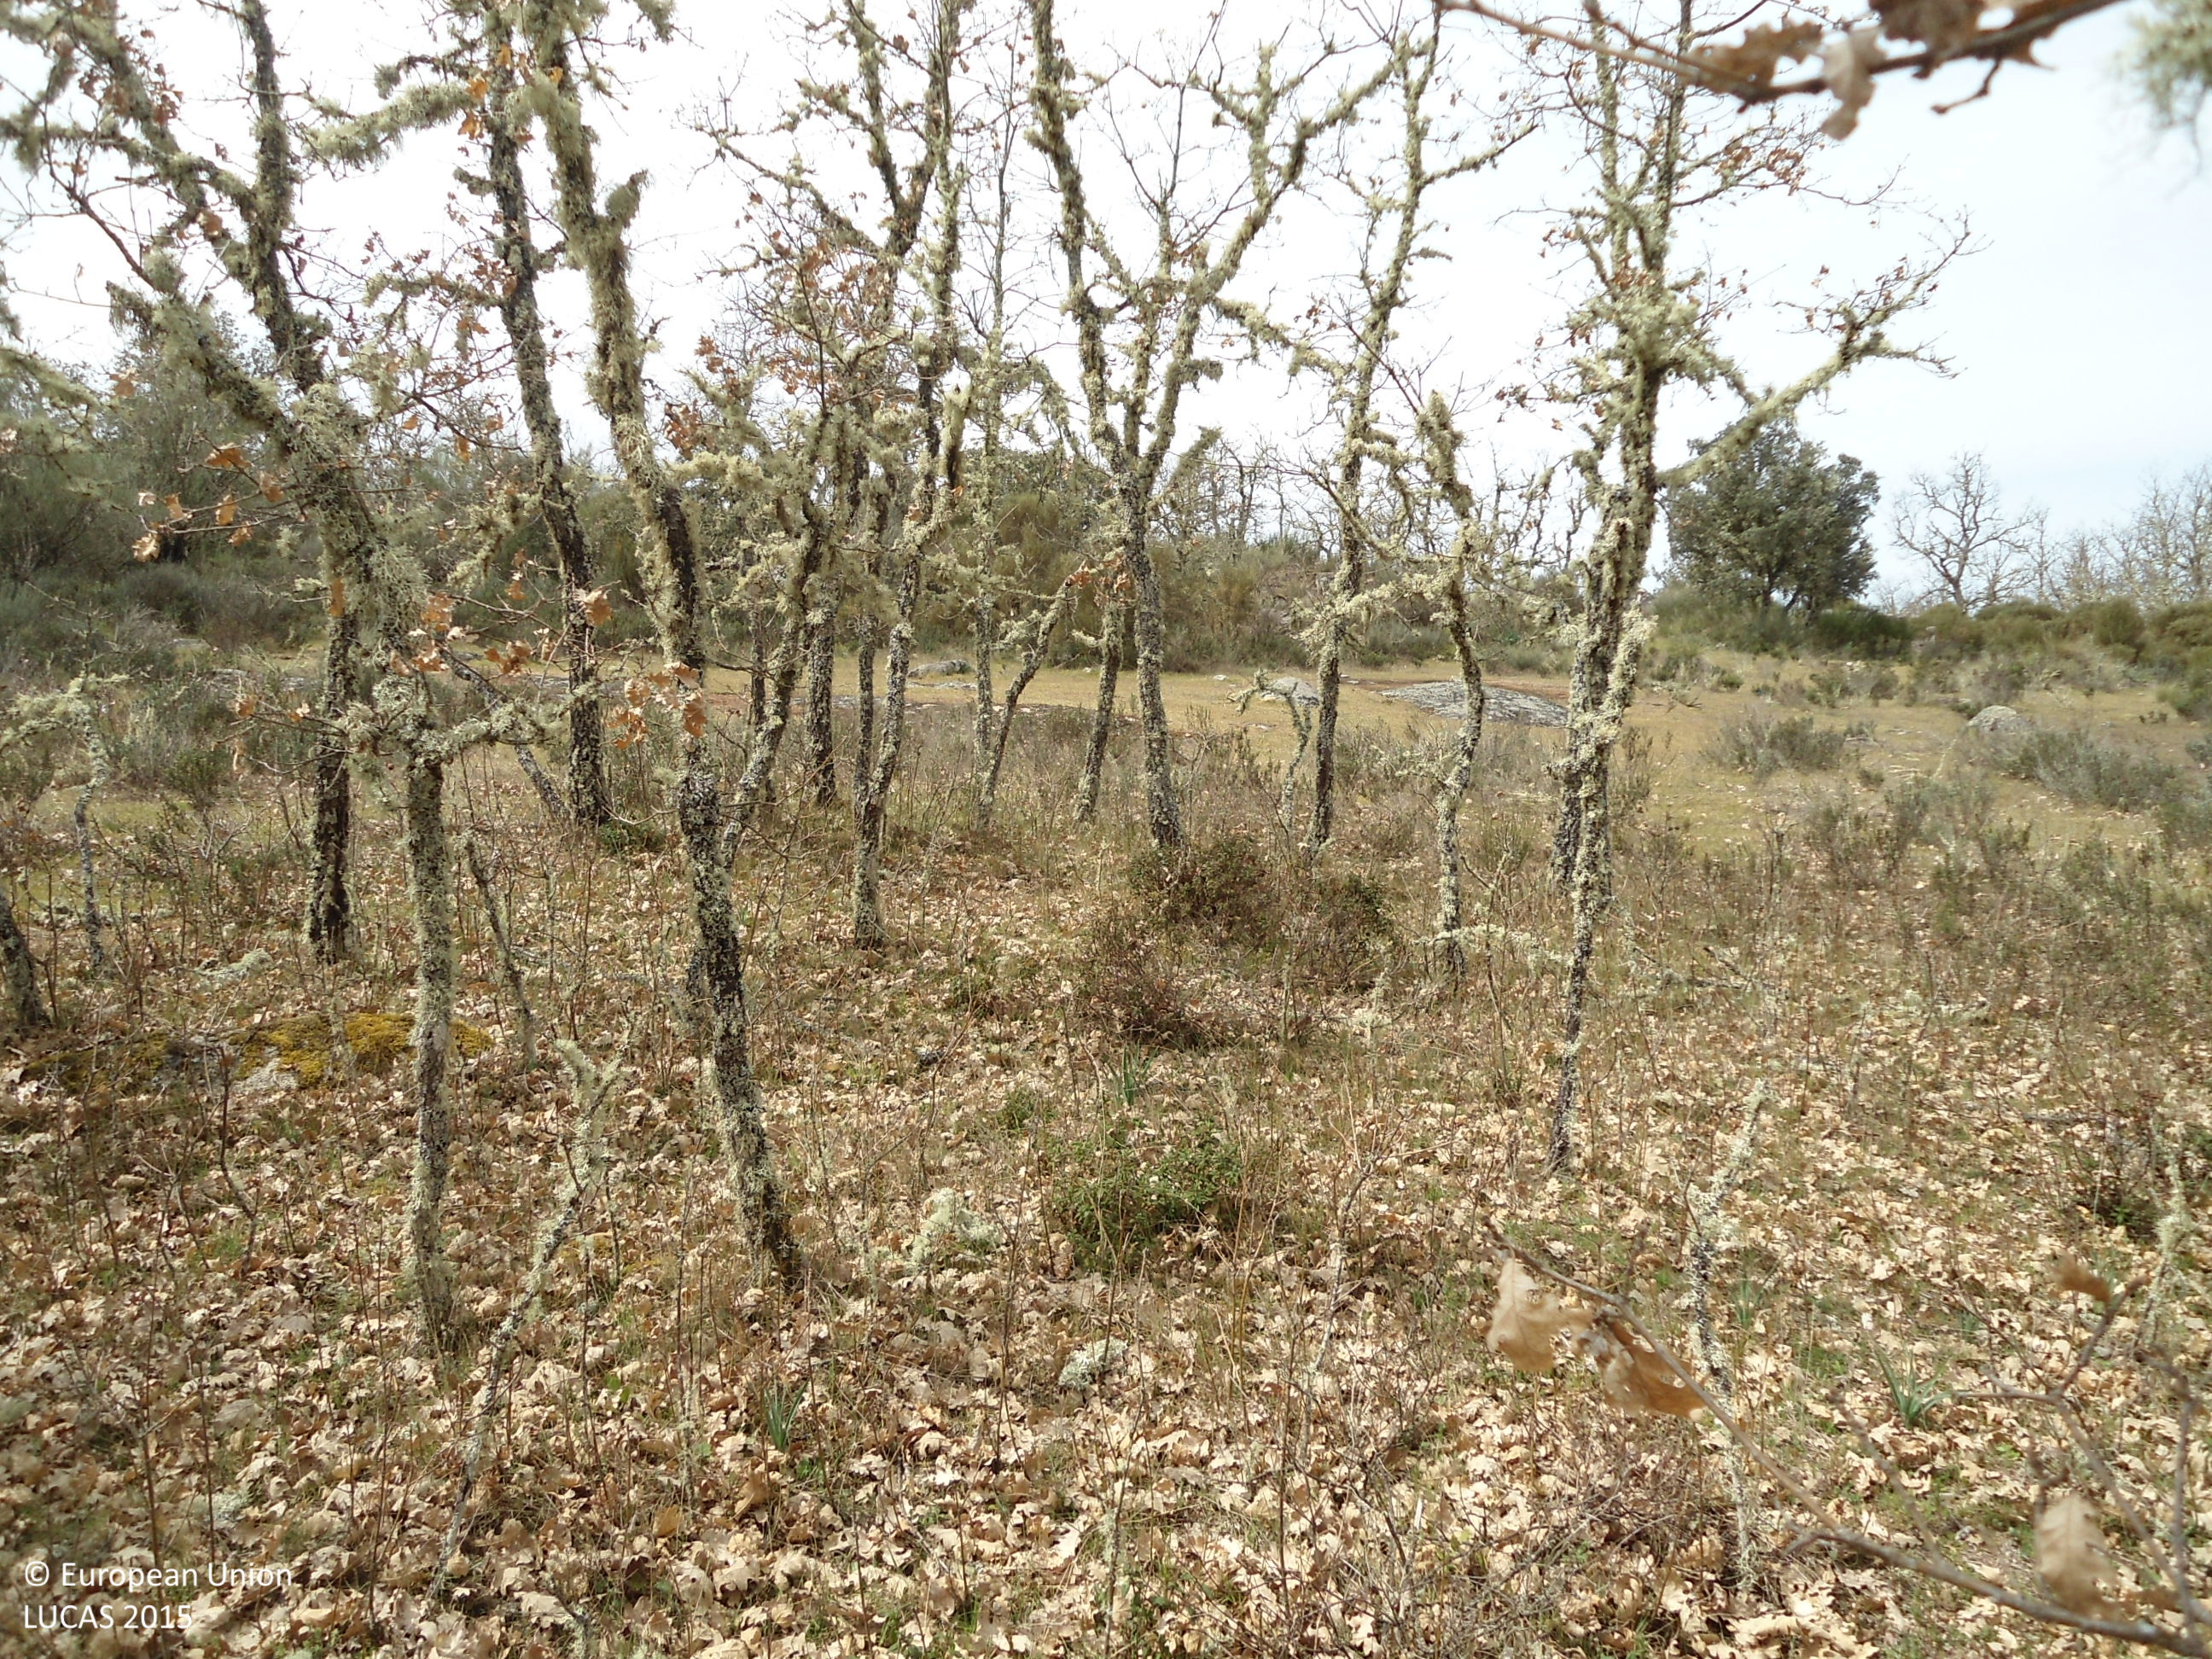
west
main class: Woodland
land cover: Broadleaved woodland
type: acidophilous oak and oak-birch forest
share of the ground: > 75 %
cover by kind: broadleaved forest trees 90 %, herbaceous plants 10 %
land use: Forestry
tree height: > 5 m
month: April
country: ES
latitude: 41.6307
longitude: -6.2192
